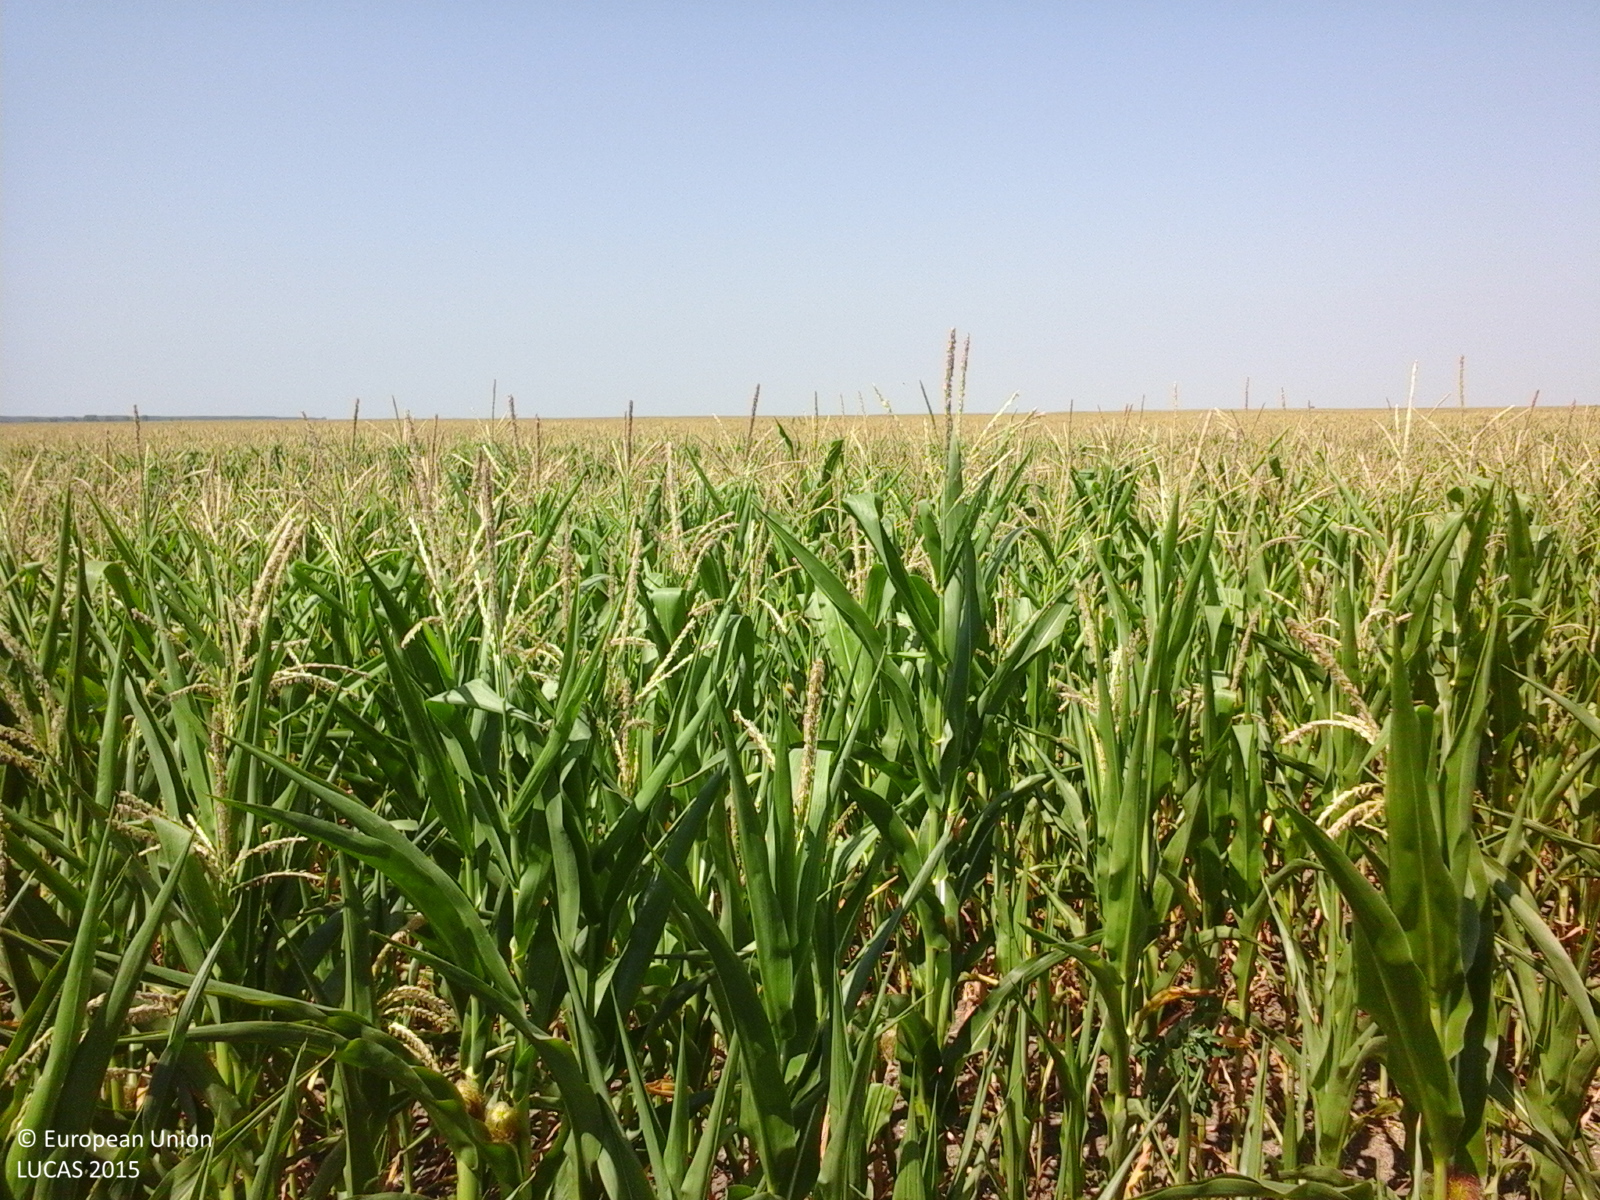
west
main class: Cropland
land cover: Maize
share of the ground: > 75 %
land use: Agriculture (excluding fallow land and kitchen gardens)
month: July
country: RO
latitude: 44.1687
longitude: 26.9962
